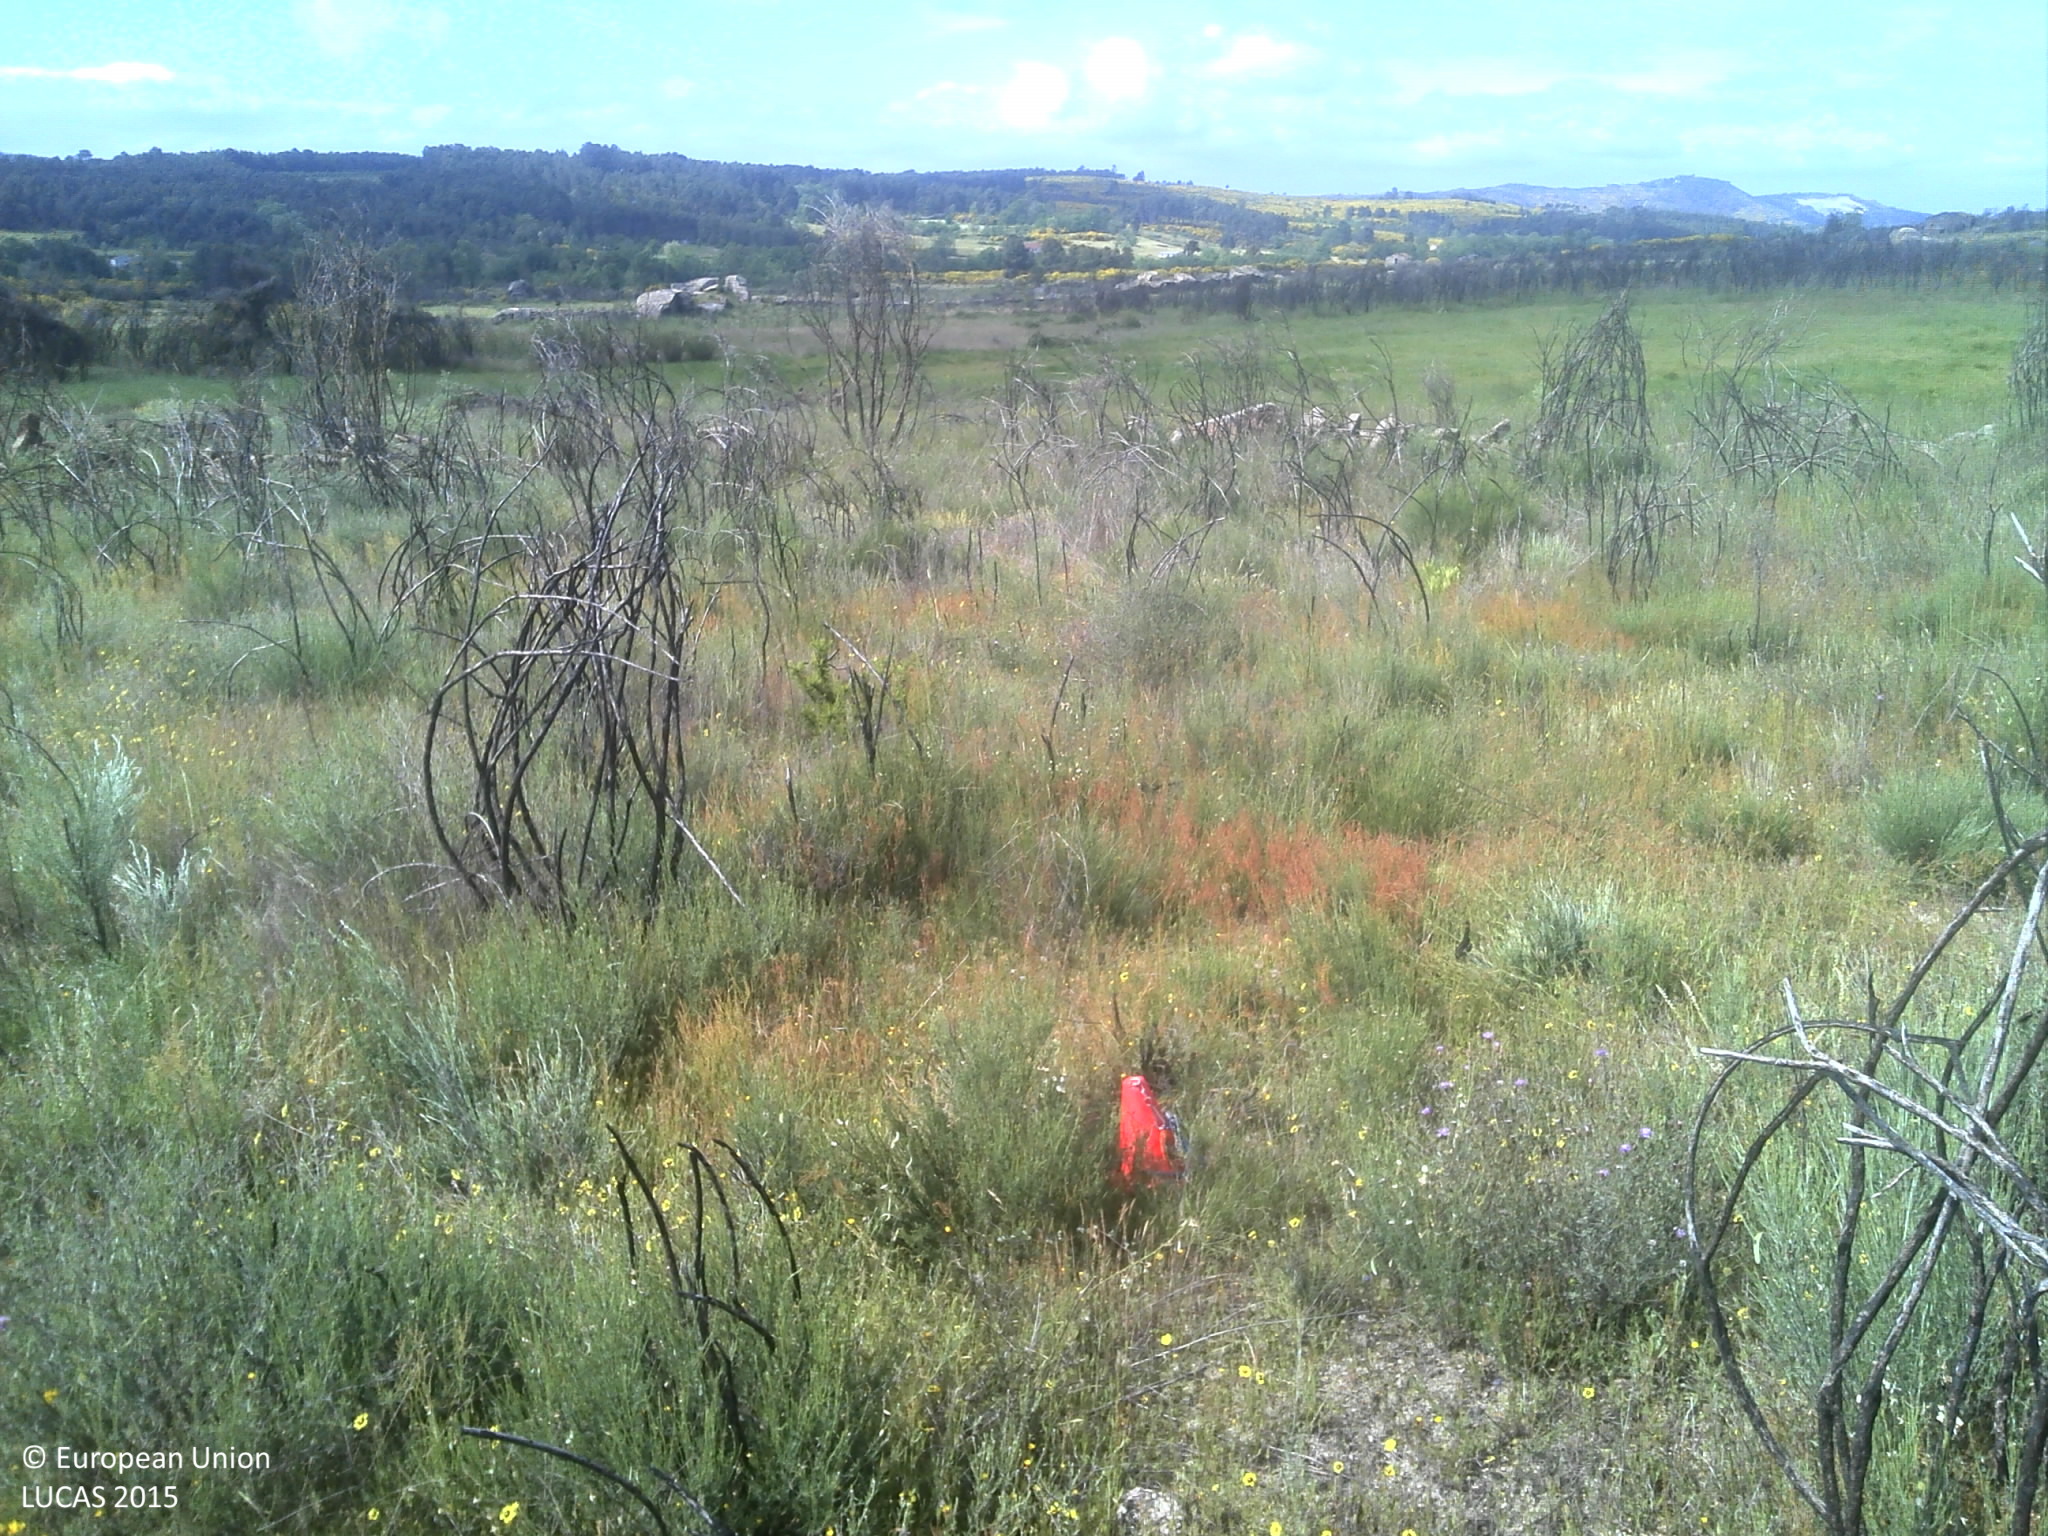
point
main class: Shrubland
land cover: Shrubland without tree cover
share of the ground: 25 - 50 %
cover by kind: shrubs 45 %, herbaceous plants 30 %, unconsolidated bare surface 20 %
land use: Abandoned areas
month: May
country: PT
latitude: 40.6668
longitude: -7.5391
